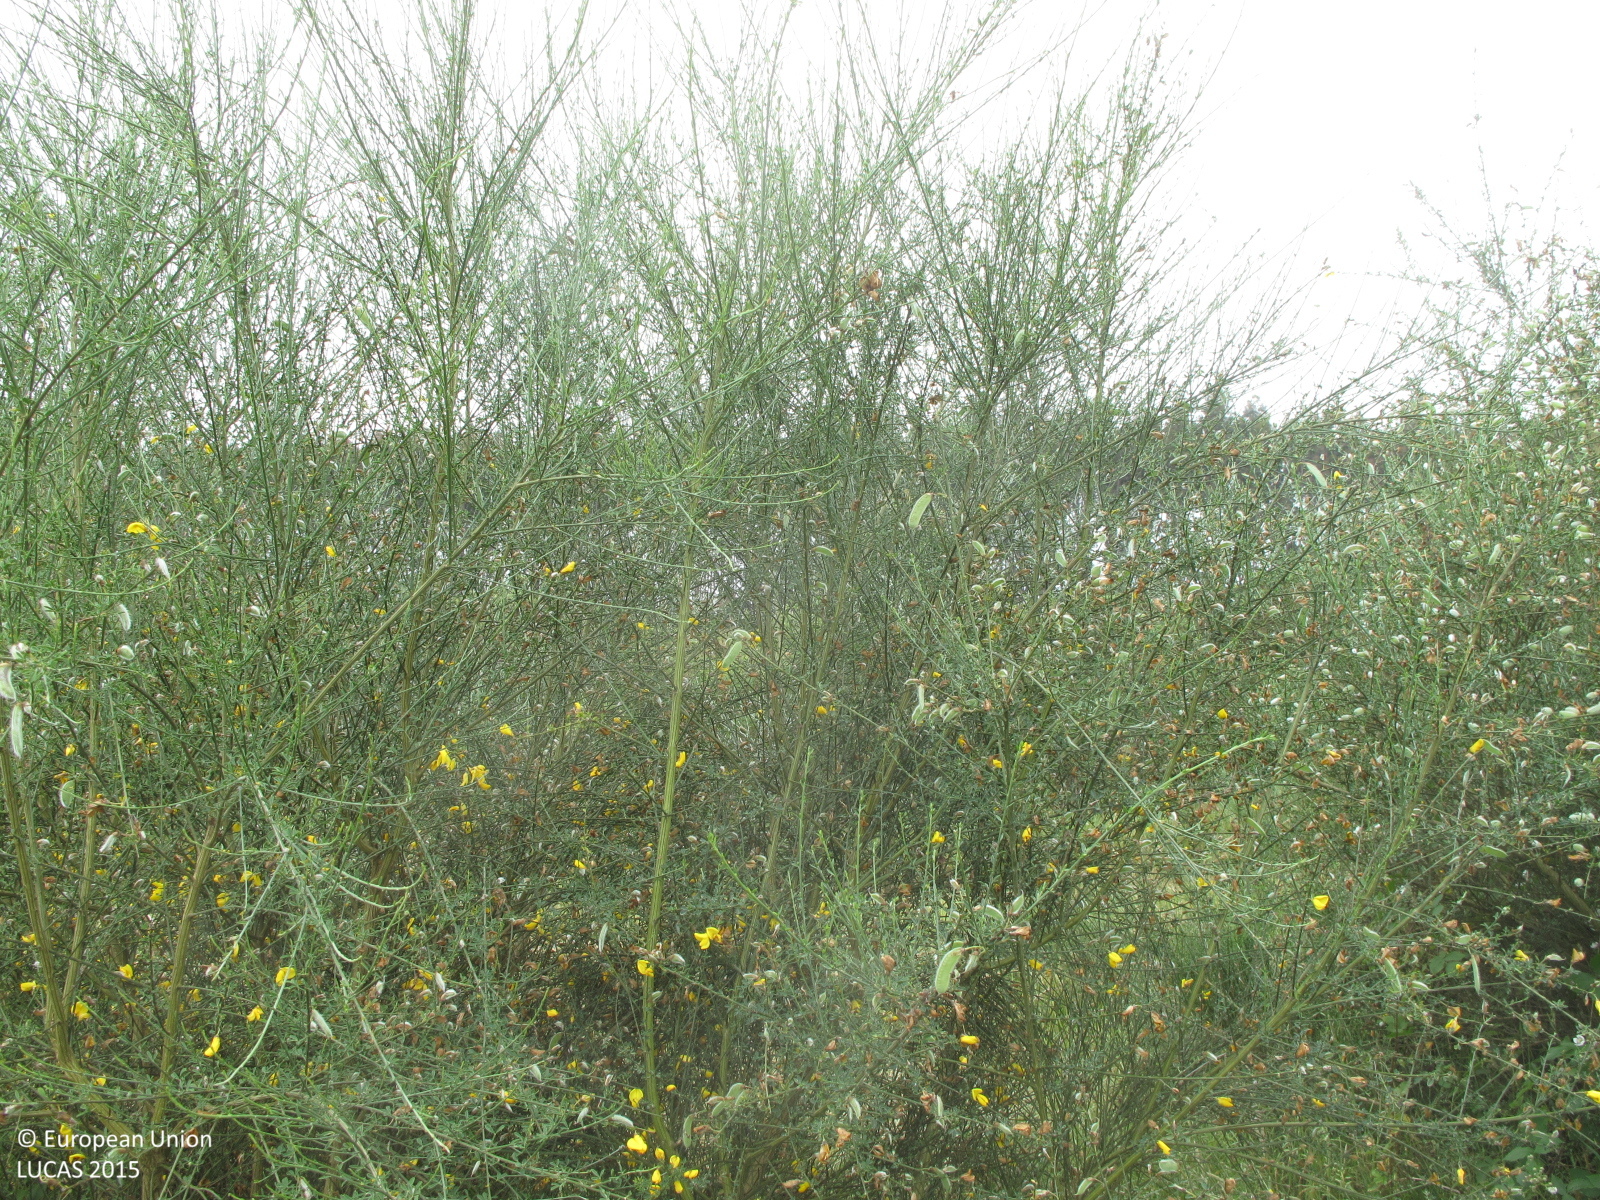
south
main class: Shrubland
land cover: Shrubland with sparse tree cover
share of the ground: > 75 %
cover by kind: shrubs 85 %, herbaceous plants 10 %, broadleaved forest trees 5 %
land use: Abandoned areas
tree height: < 5 m
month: June
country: ES
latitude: 43.1511
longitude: -8.0846
